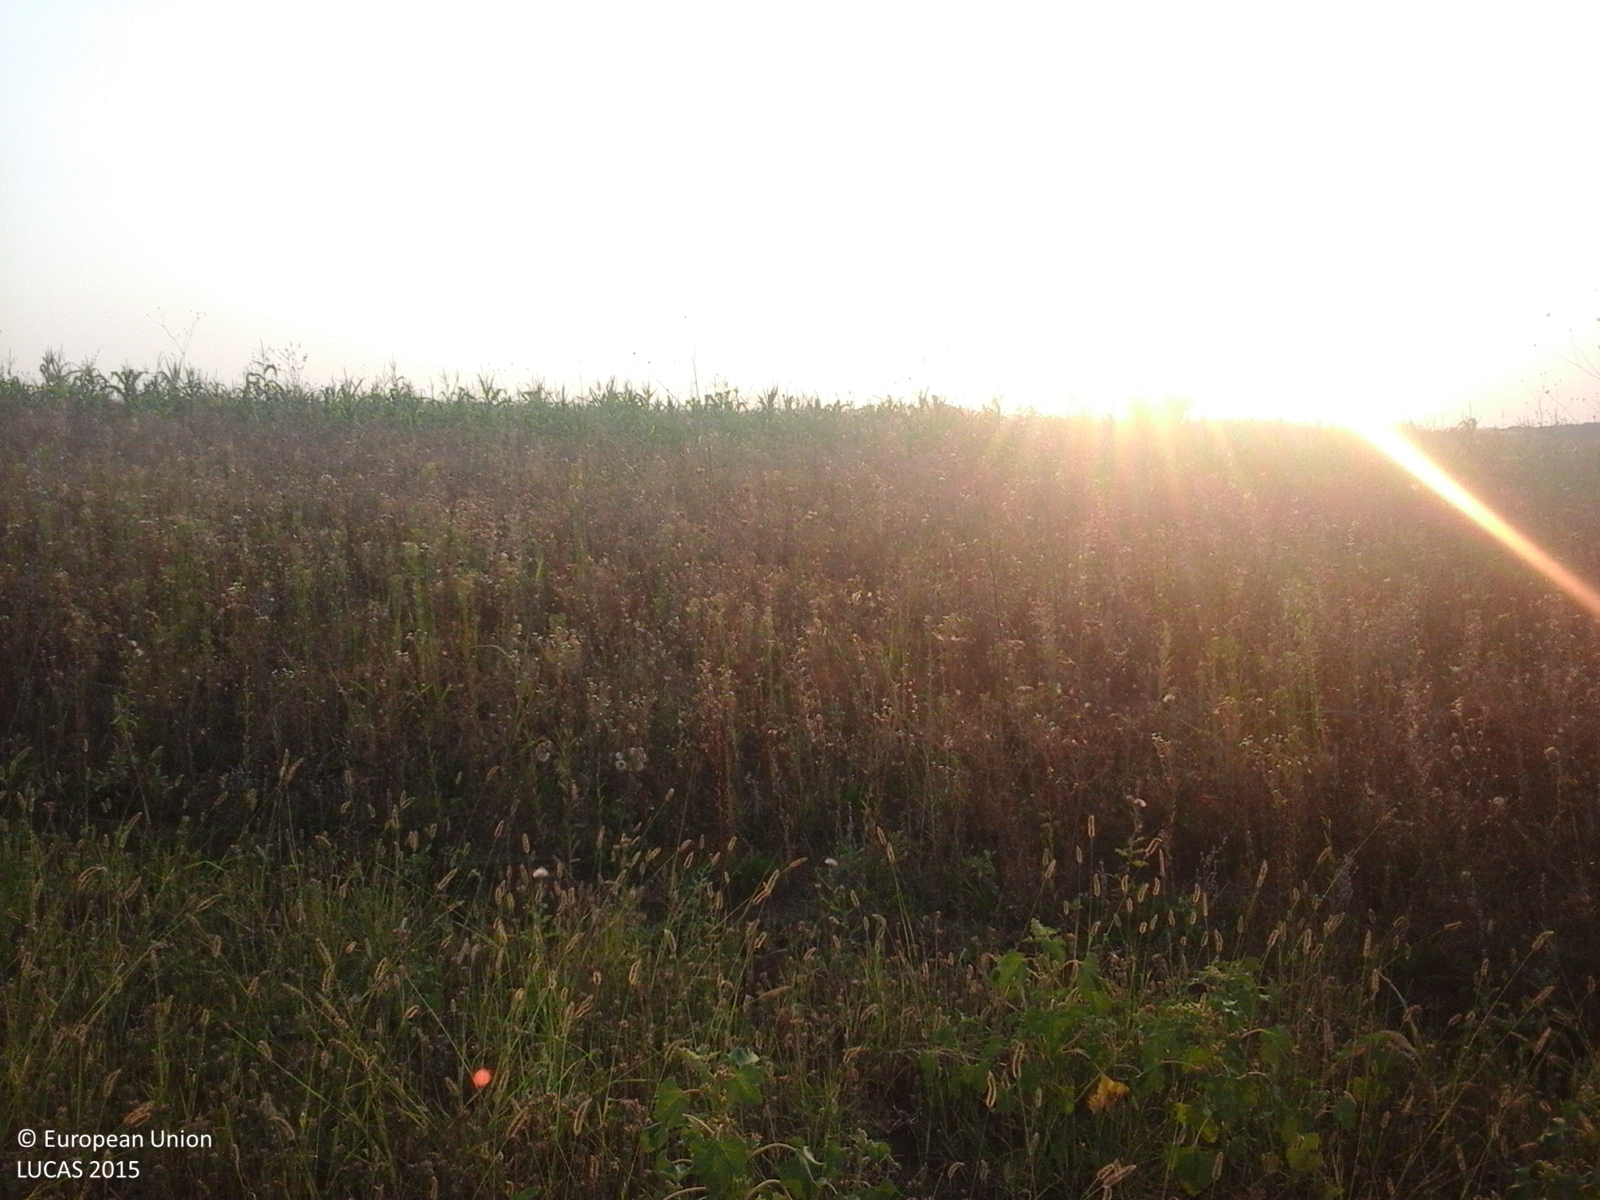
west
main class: Grassland
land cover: Spontaneously vegetated surfaces
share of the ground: > 75 %
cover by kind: herbaceous plants 100 %
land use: Fallow land
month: August
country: RO
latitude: 44.2311
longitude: 23.6370
